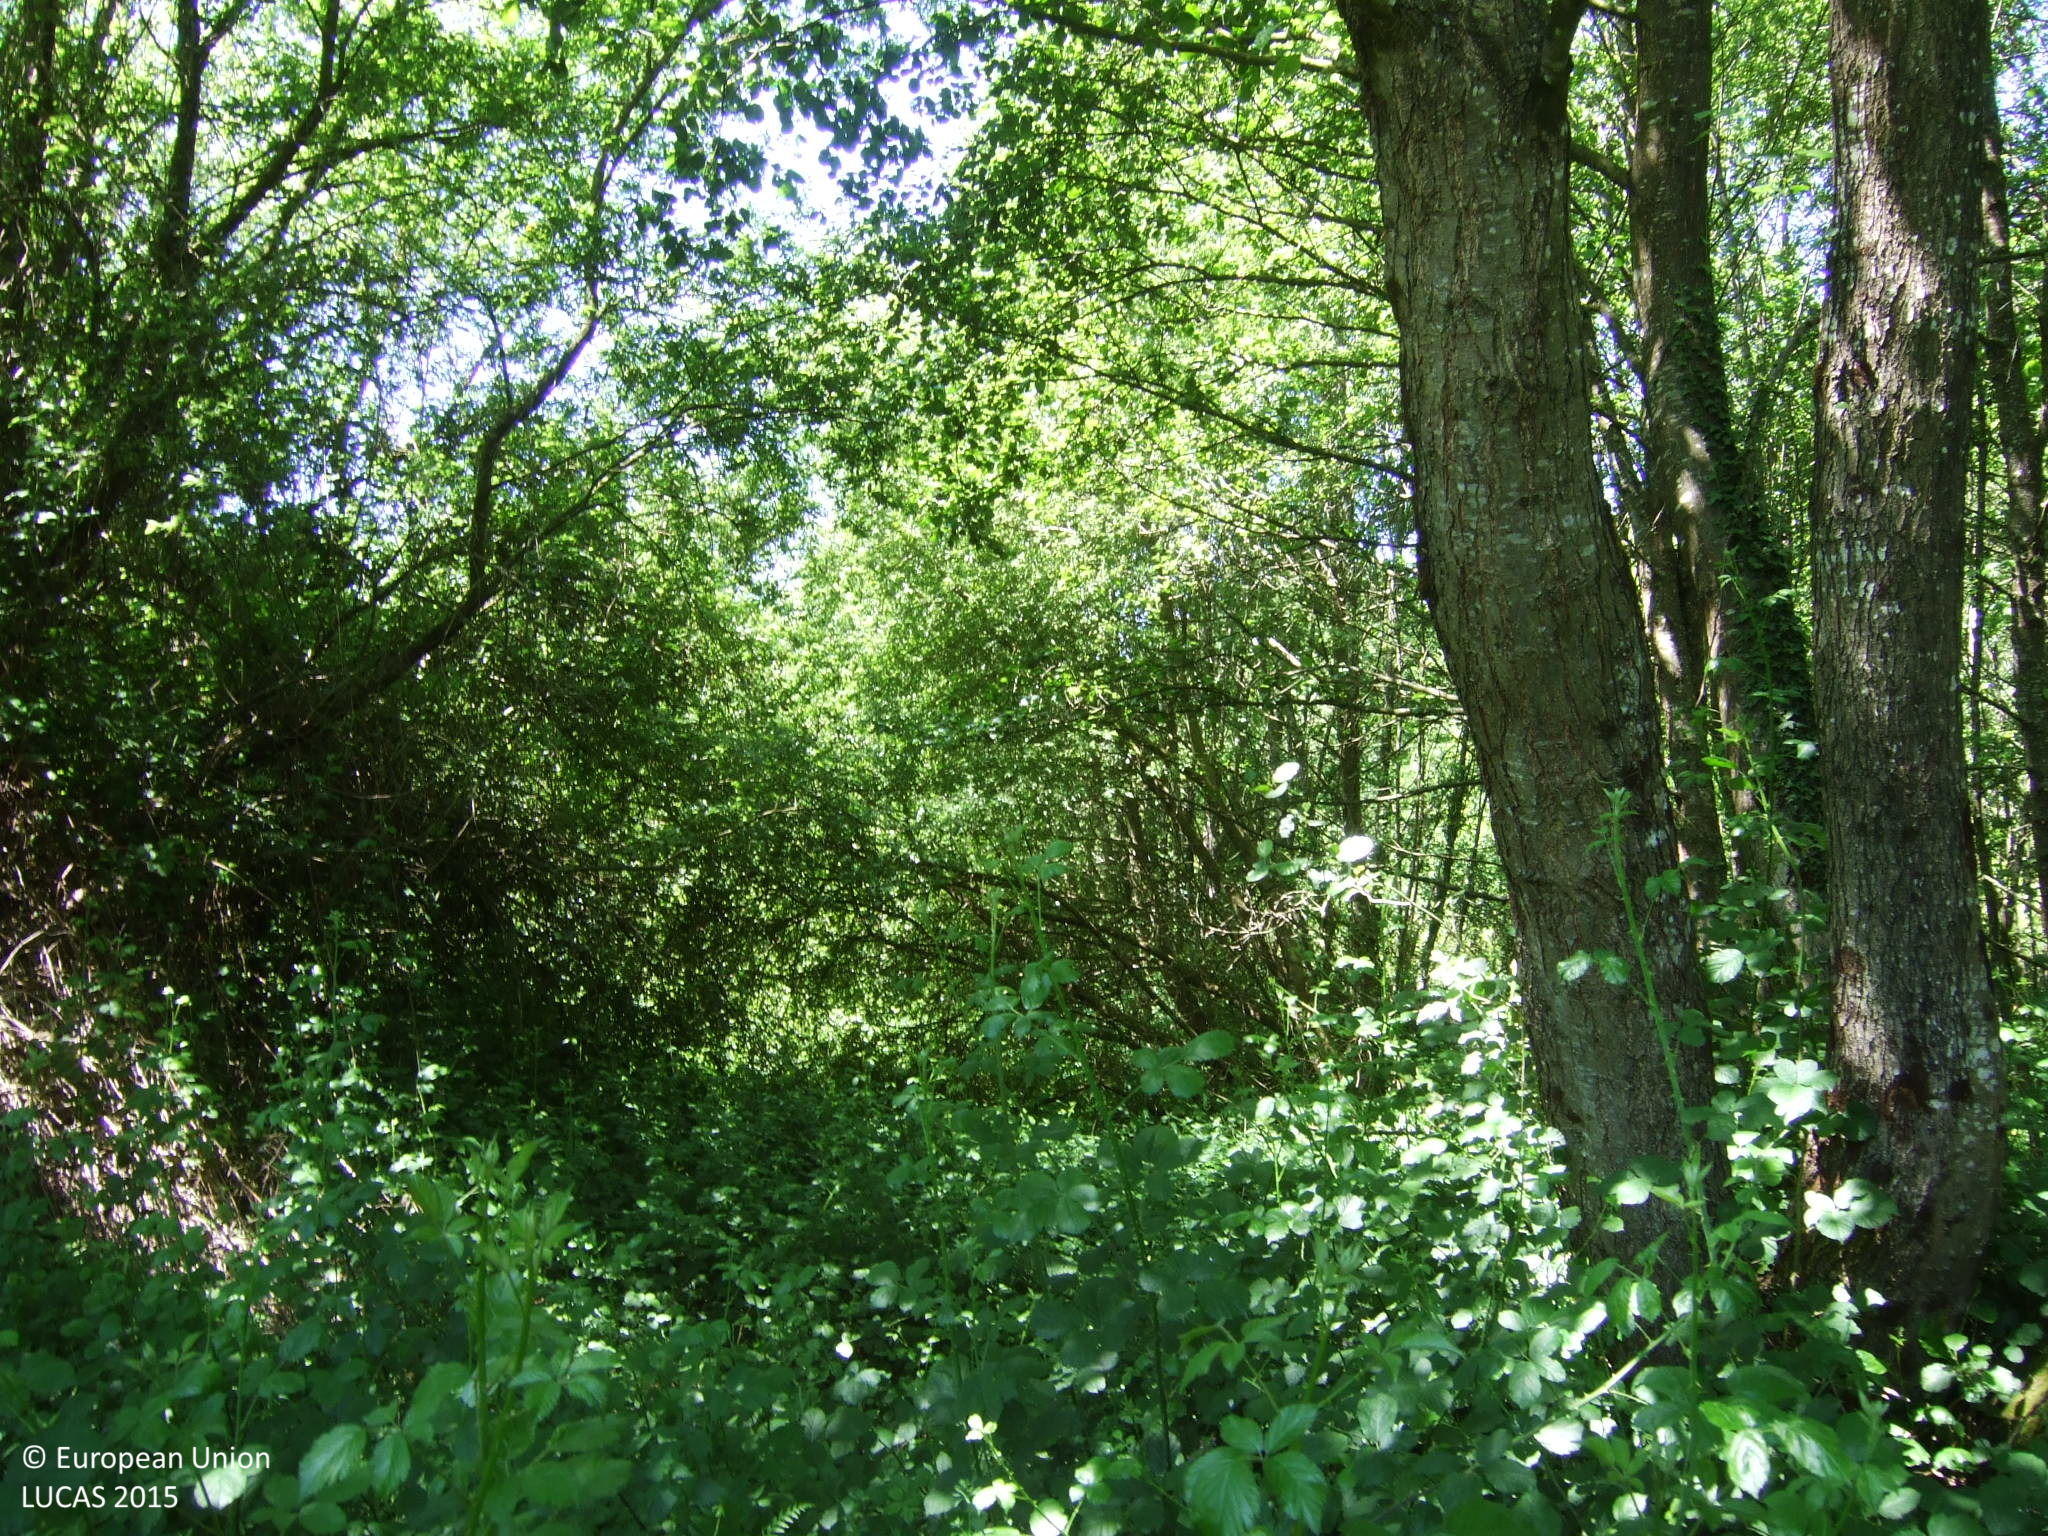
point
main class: Woodland
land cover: Broadleaved woodland
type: acidophilous oak and oak-birch forest
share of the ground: > 75 %
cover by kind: broadleaved forest trees 80 %, shrubs 20 %
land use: Semi-natural and natural areas not in use
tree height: > 5 m
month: May
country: ES
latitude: 42.8697
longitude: -7.5932
